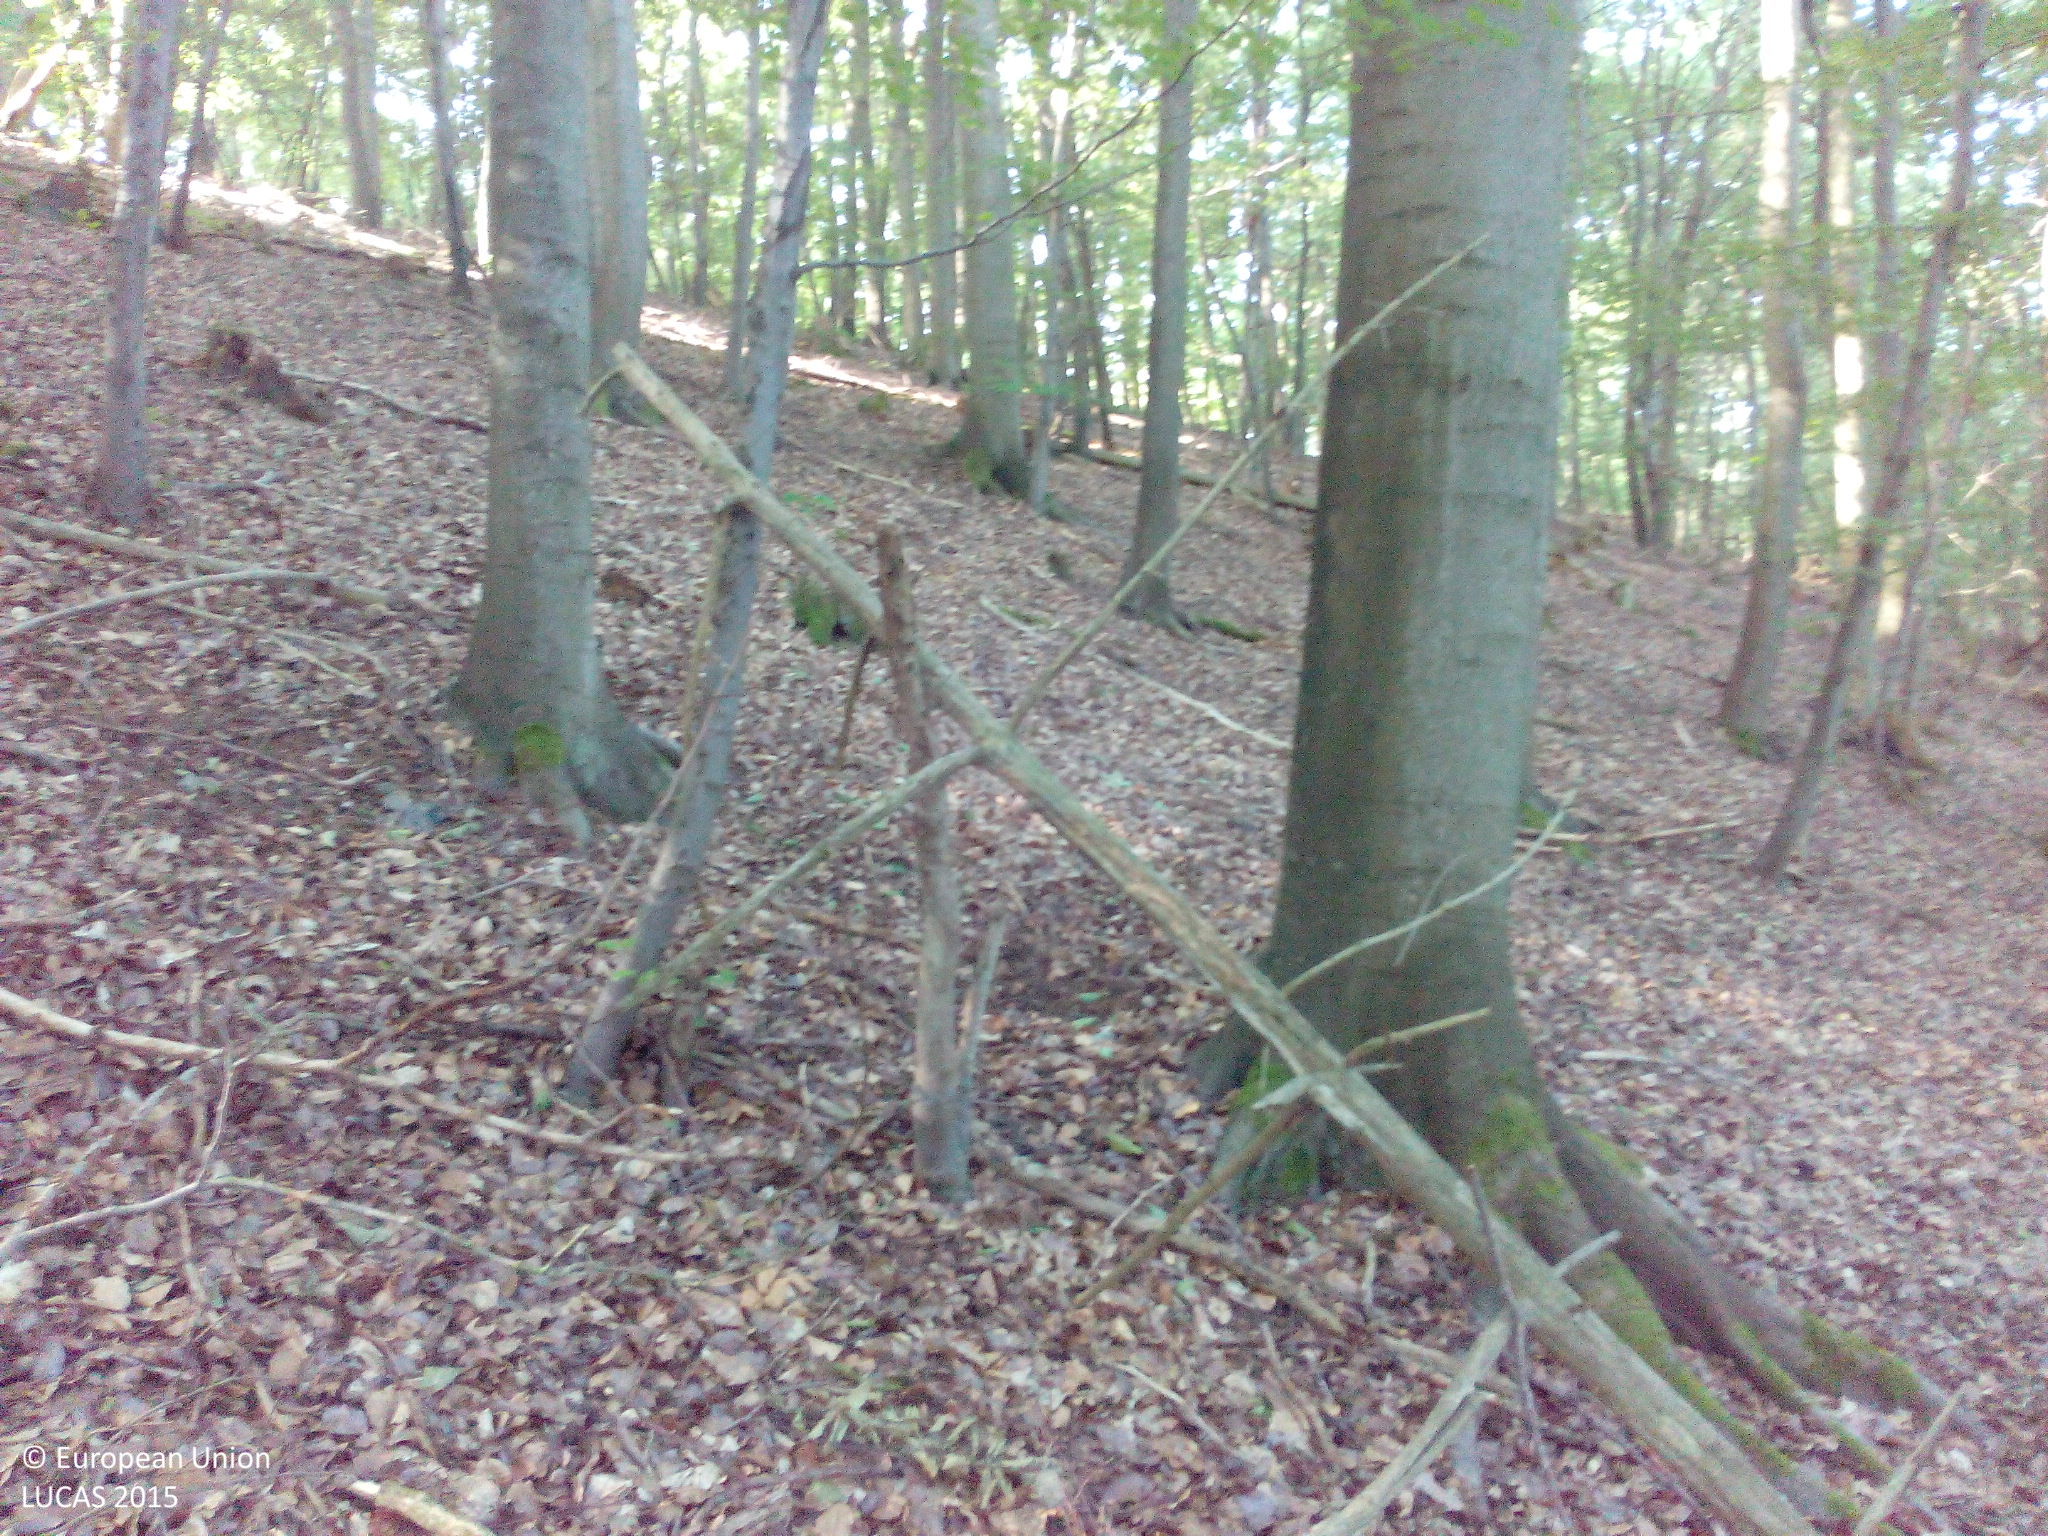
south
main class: Woodland
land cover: Broadleaved woodland
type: beech forest
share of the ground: > 75 %
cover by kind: broadleaved forest trees 90 %, unconsolidated bare surface 10 %
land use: Forestry
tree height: > 5 m
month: July
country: DE
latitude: 49.8153
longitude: 7.5127
